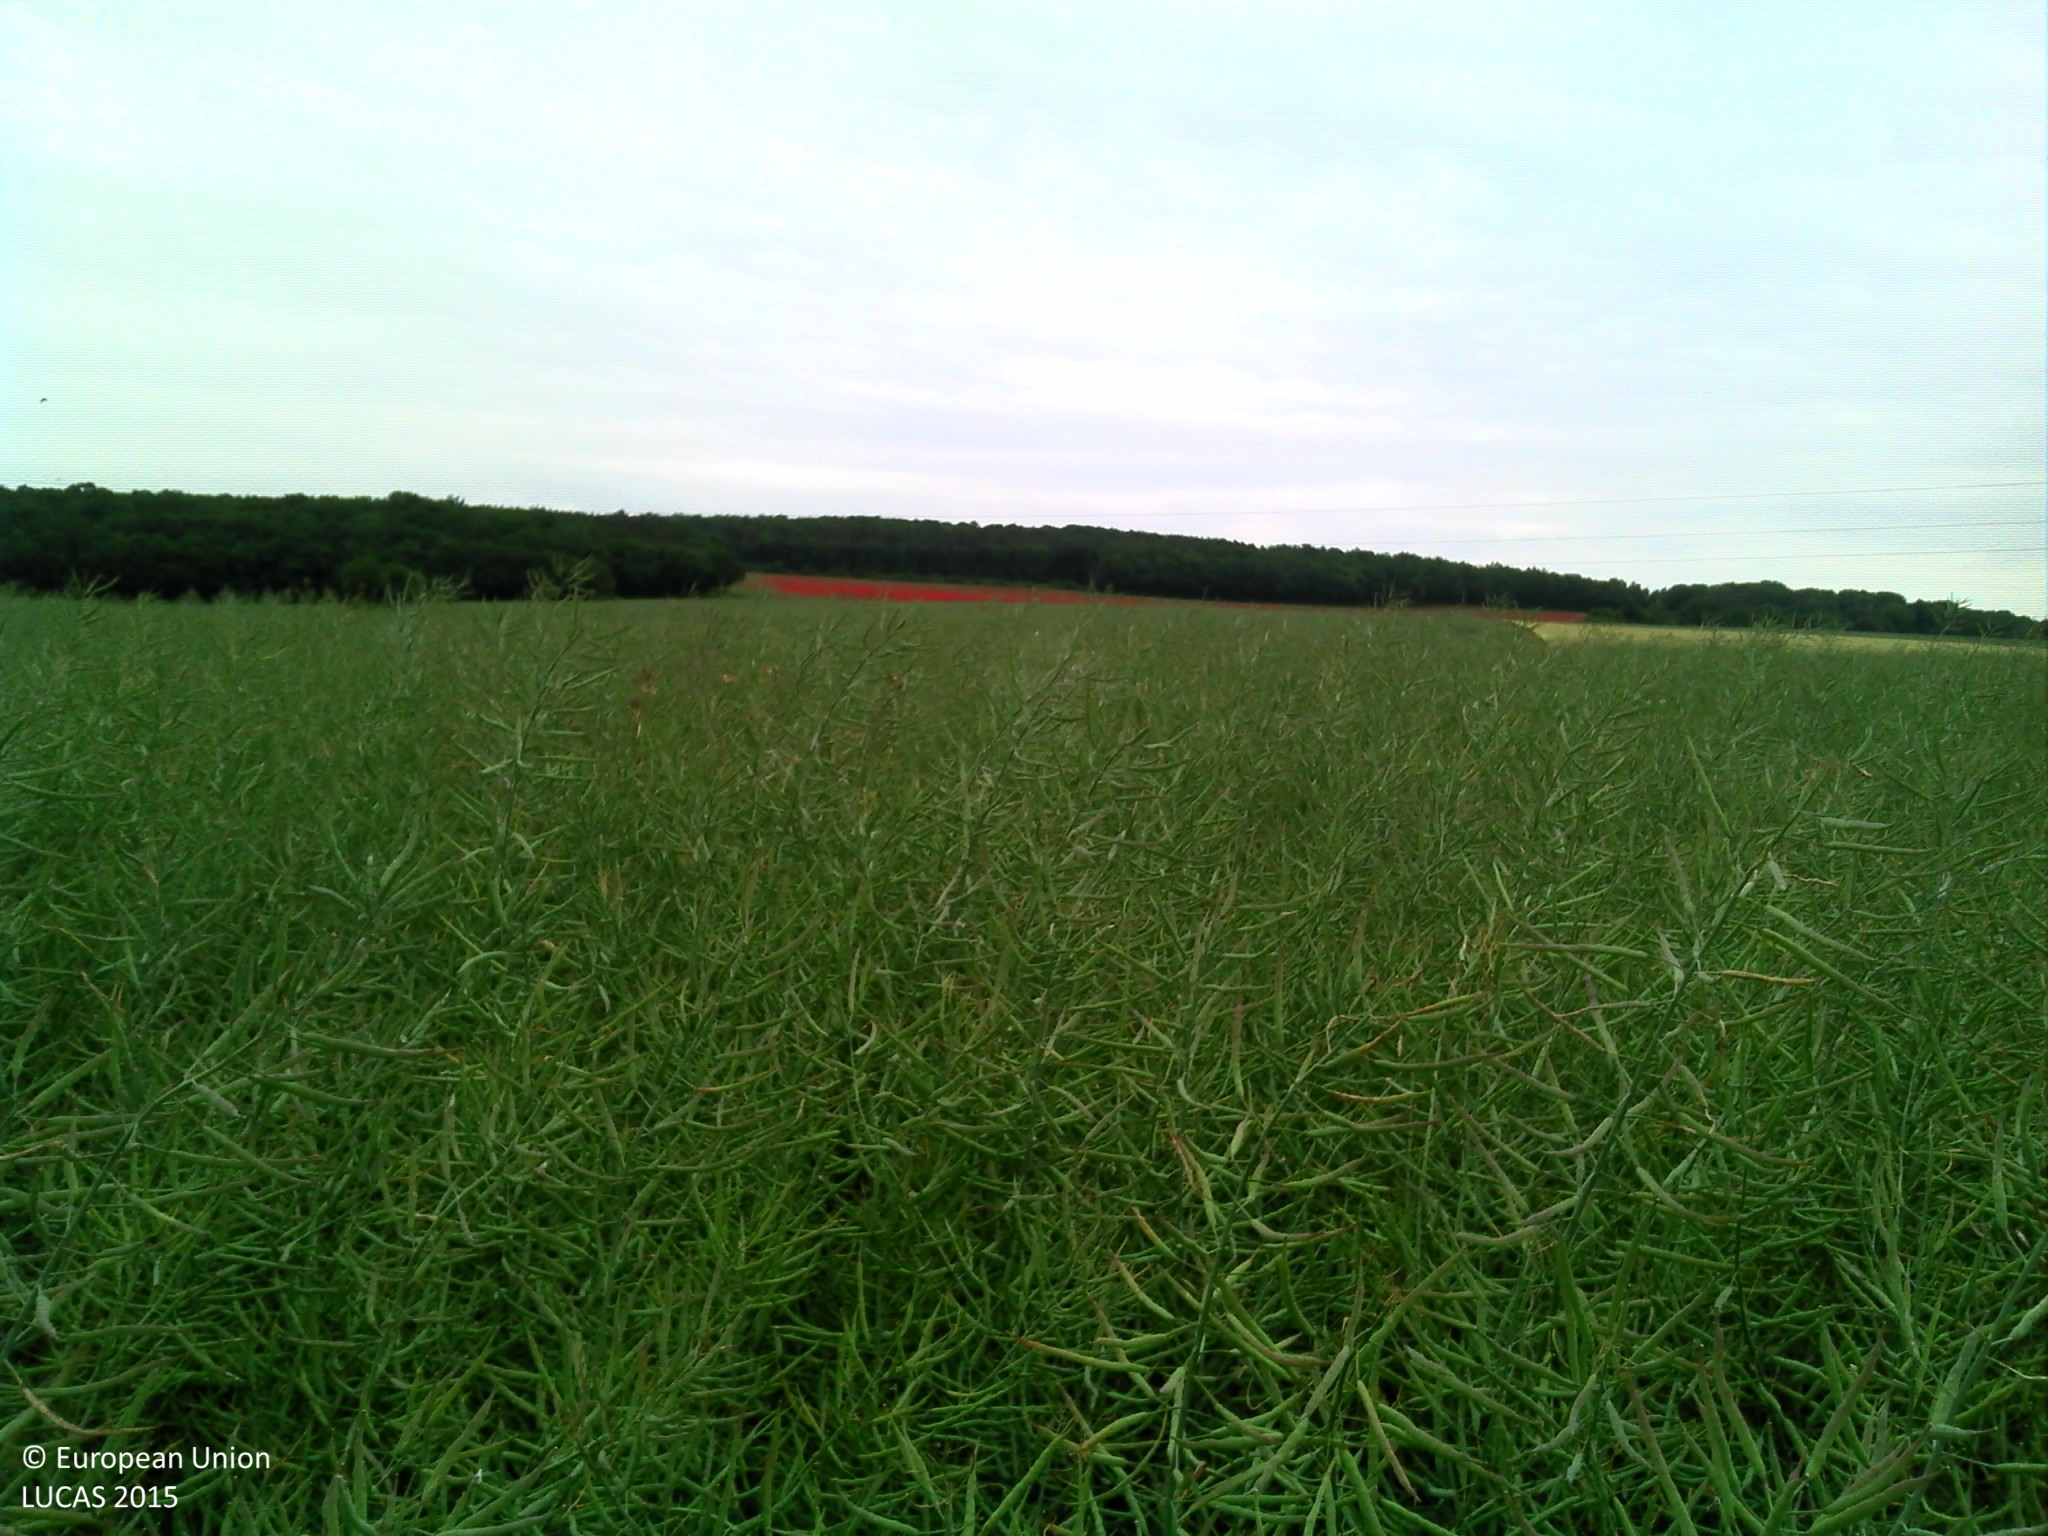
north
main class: Cropland
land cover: Rape and turnip rape
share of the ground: > 75 %
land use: Agriculture (excluding fallow land and kitchen gardens)
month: May
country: FR
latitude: 47.1266
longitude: 2.8896
